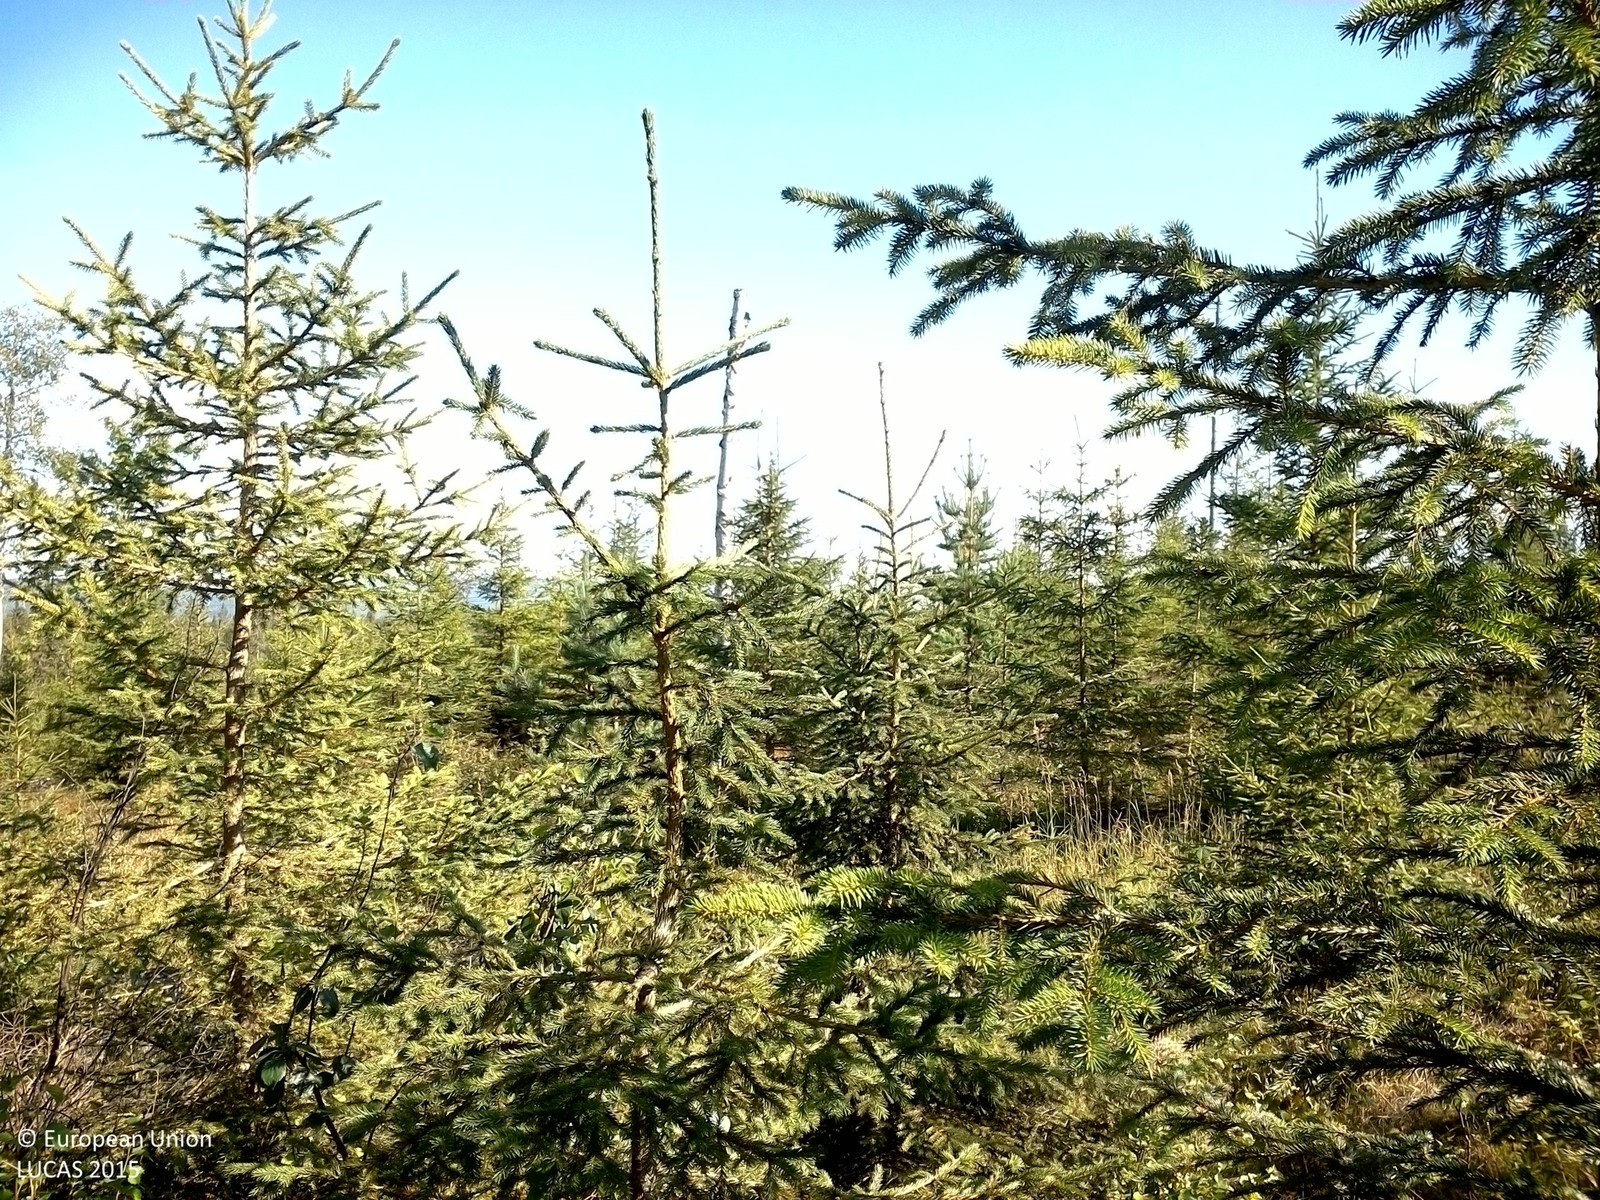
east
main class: Woodland
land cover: Spruce dominated mixed woodland
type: boreal forest
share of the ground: 50 - 75 %
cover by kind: coniferous forest trees 50 %, broadleaved forest trees 20 %, shrubs 10 %, herbaceous plants 10 %, lichens and mosses 10 %
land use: Forestry
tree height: < 5 m
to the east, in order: Spruce dominated mixed woodland; Spruce dominated coniferous woodland; Spruce dominated mixed woodland; Broadleaved woodland; Electric lines; Broadleaved woodland; Spruce dominated coniferous woodland
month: August
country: SE
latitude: 63.8051
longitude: 17.4643
